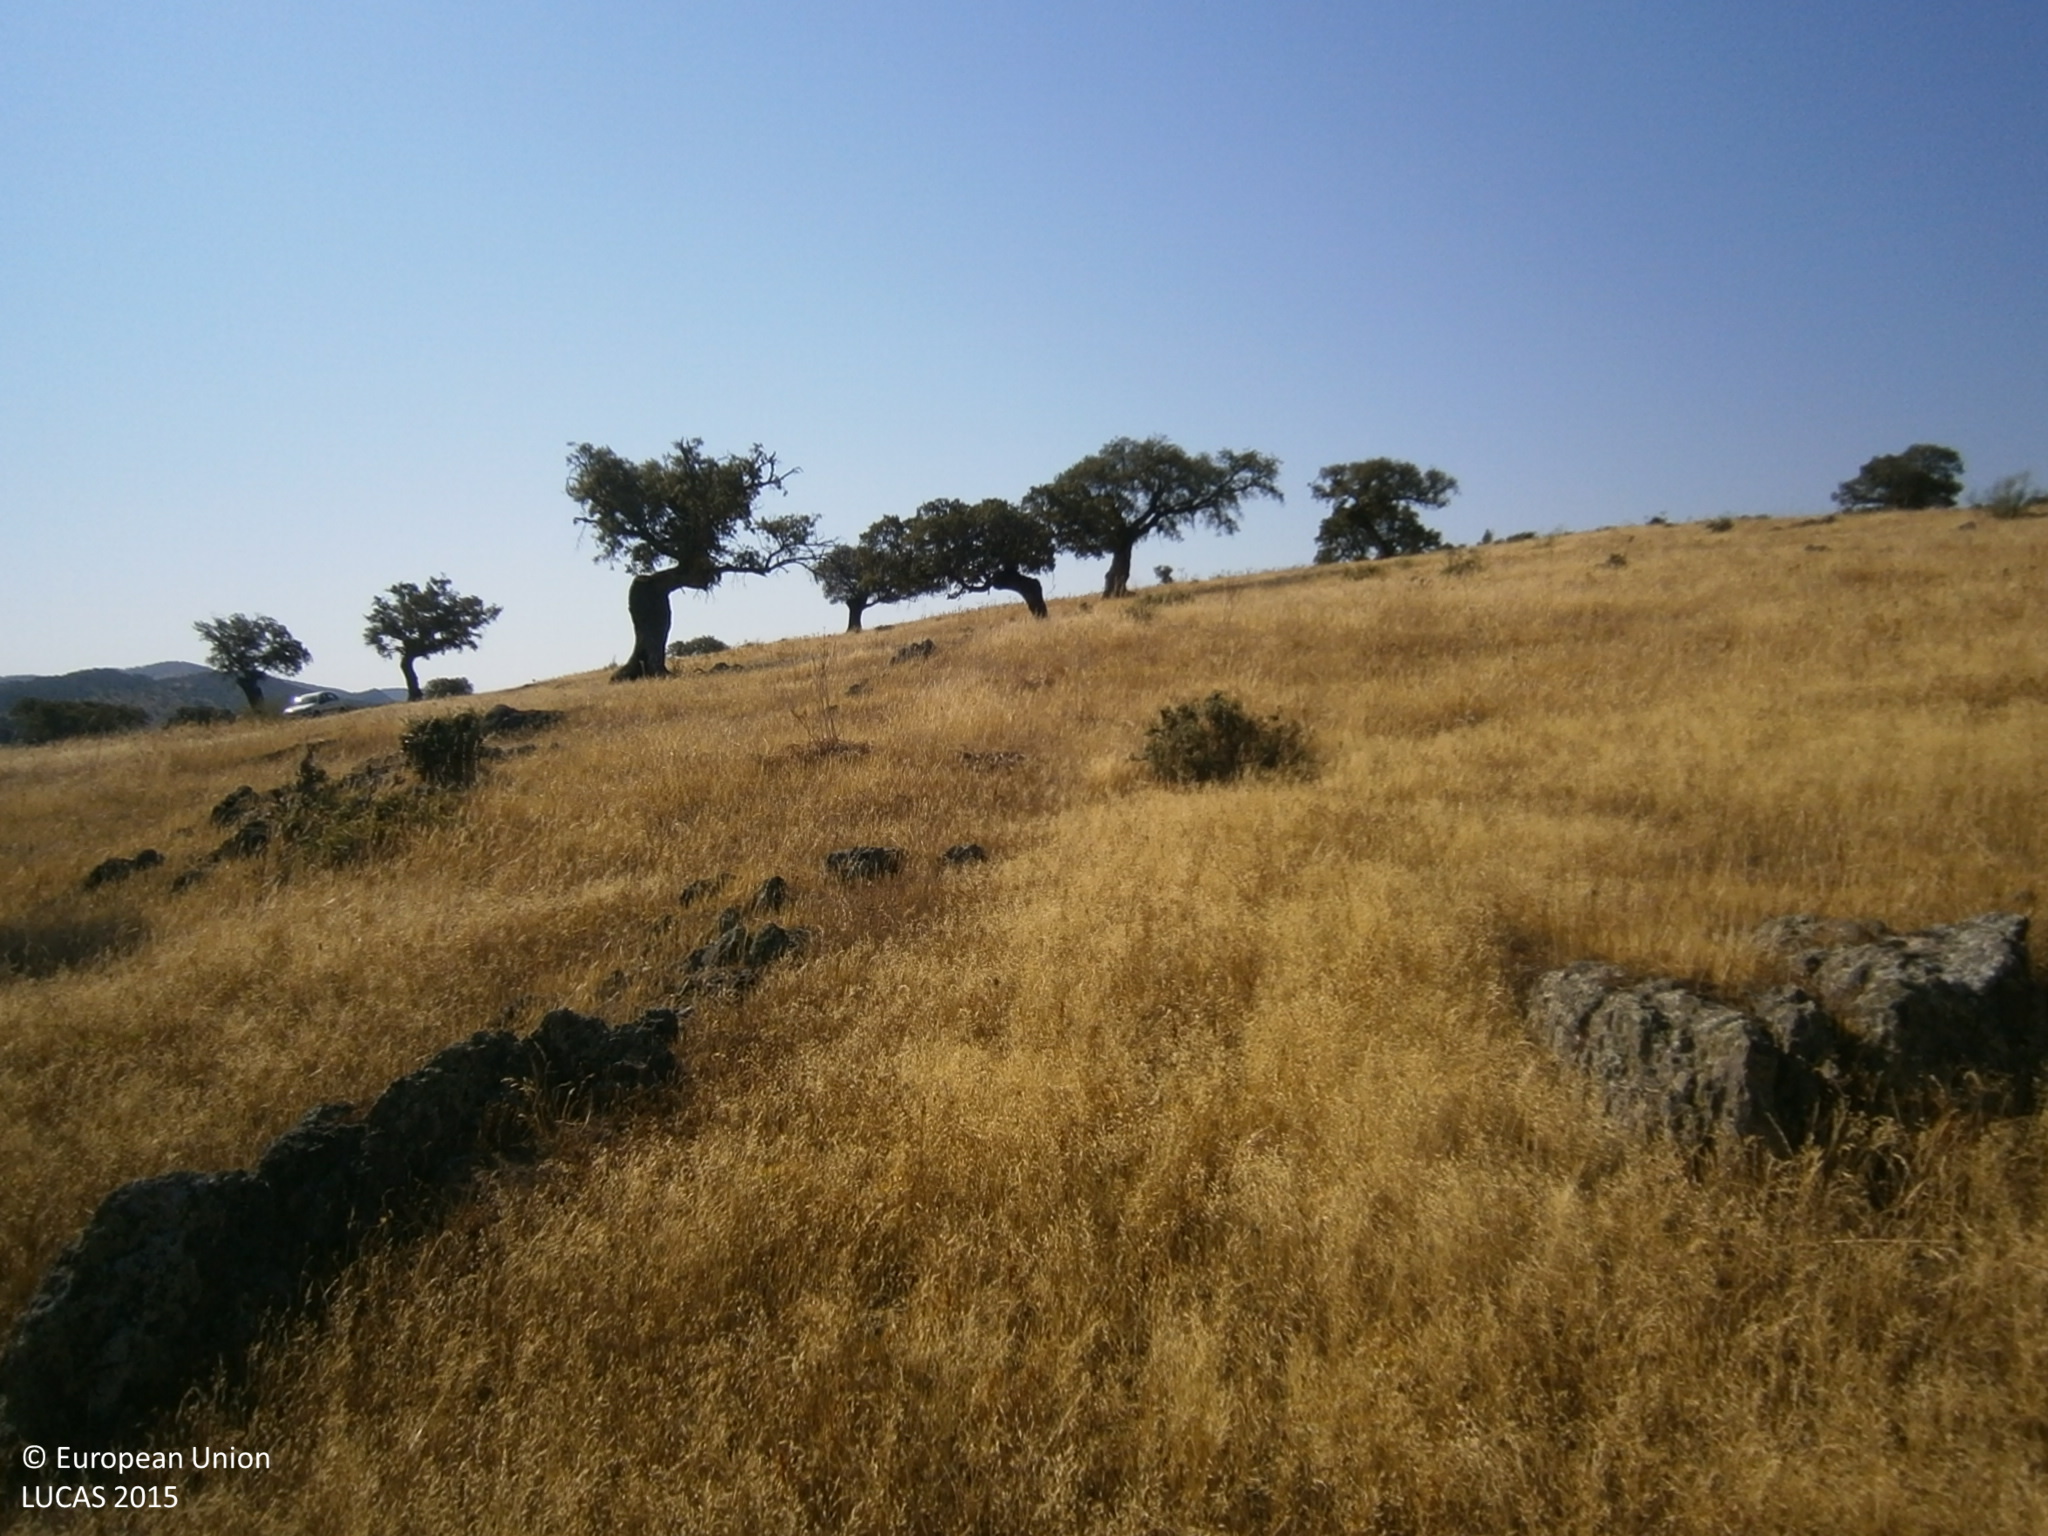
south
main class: Grassland
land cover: Grassland with sparse tree/shrub cover
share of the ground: > 75 %
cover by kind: herbaceous plants 90 %, broadleaved forest trees 5 %, shrubs 5 %
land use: Agriculture (excluding fallow land and kitchen gardens)
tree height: > 5 m
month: June
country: ES
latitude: 38.5997
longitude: -6.7202
